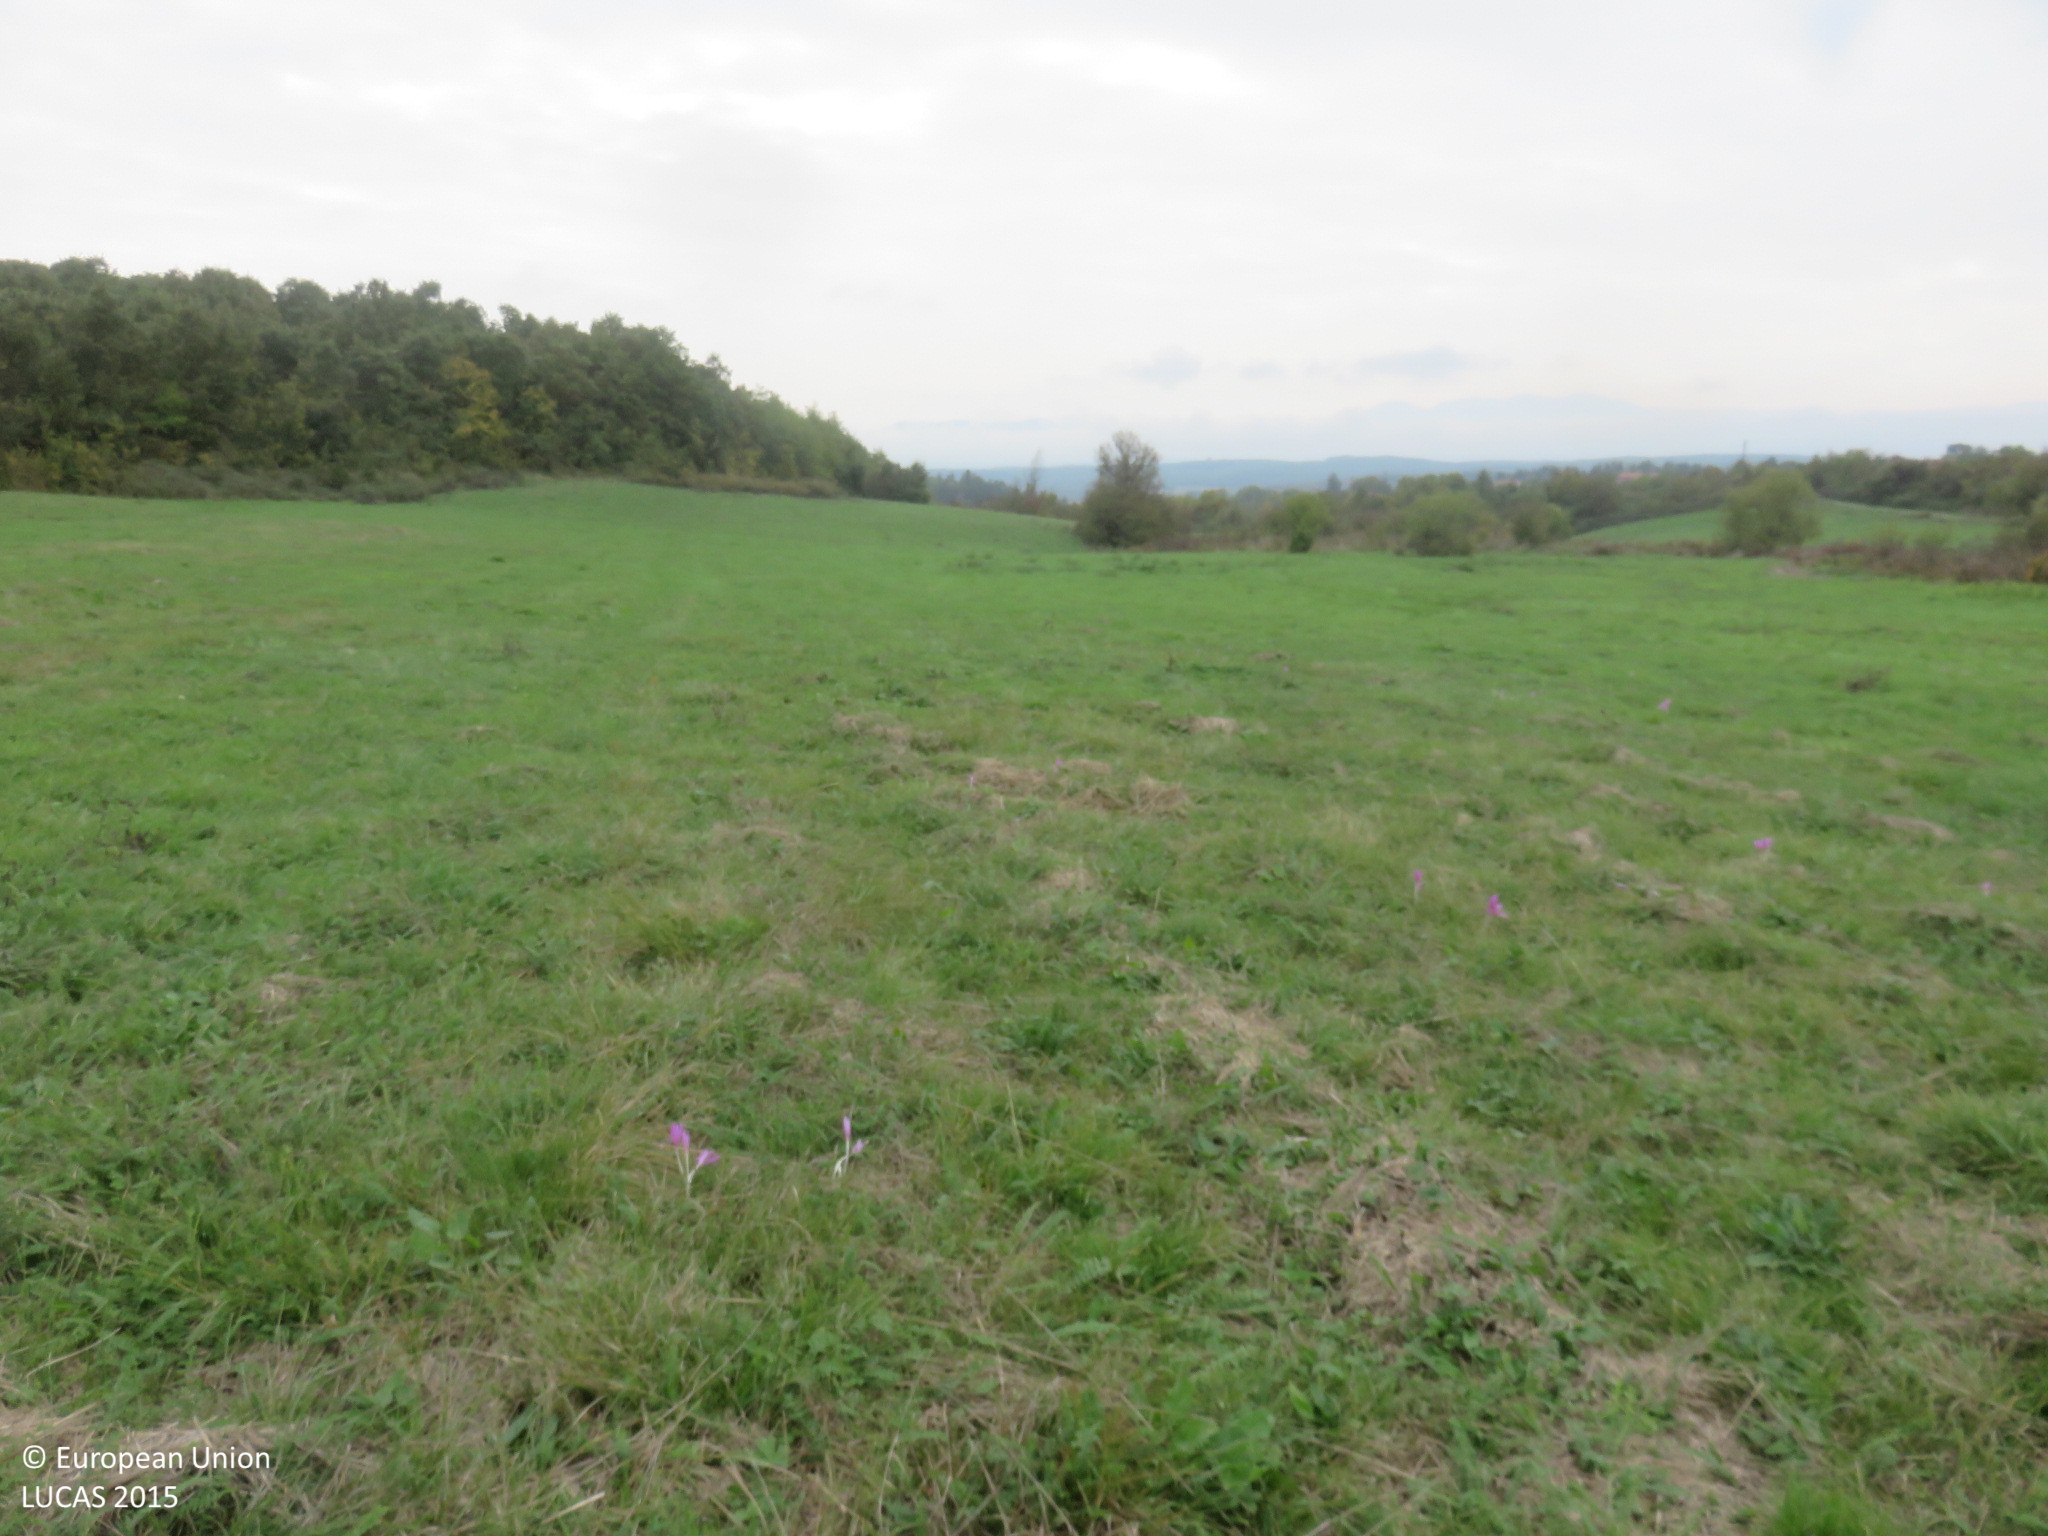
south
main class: Grassland
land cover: Grassland without tree/shrub cover
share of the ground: > 75 %
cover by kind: herbaceous plants 100 %
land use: Agriculture (excluding fallow land and kitchen gardens)
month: October
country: BG
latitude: 42.9720
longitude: 25.1623
